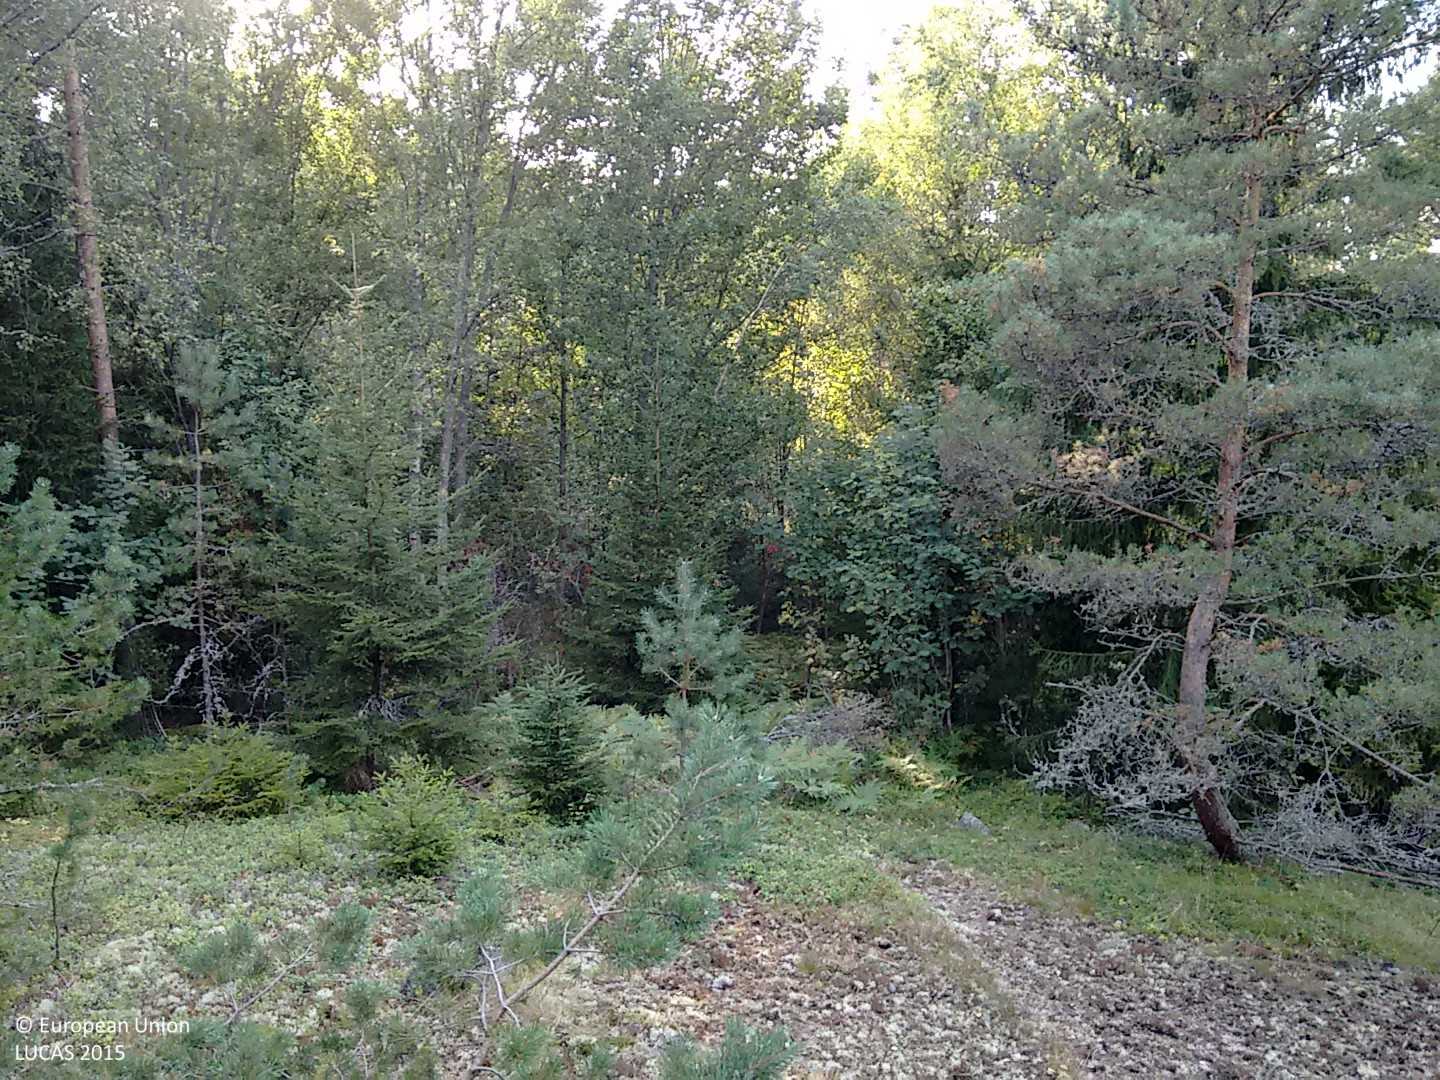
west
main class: Woodland
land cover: Pine dominated coniferous woodland
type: hemiboreal forest and nemoral coniferous forest and mixed broadleaved-coniferous forest
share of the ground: 50 - 75 %
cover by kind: coniferous forest trees 70 %, lichens and mosses 20 %, shrubs 10 %
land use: Forestry
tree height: > 5 m
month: August
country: FI
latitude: 60.0235
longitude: 20.5092
